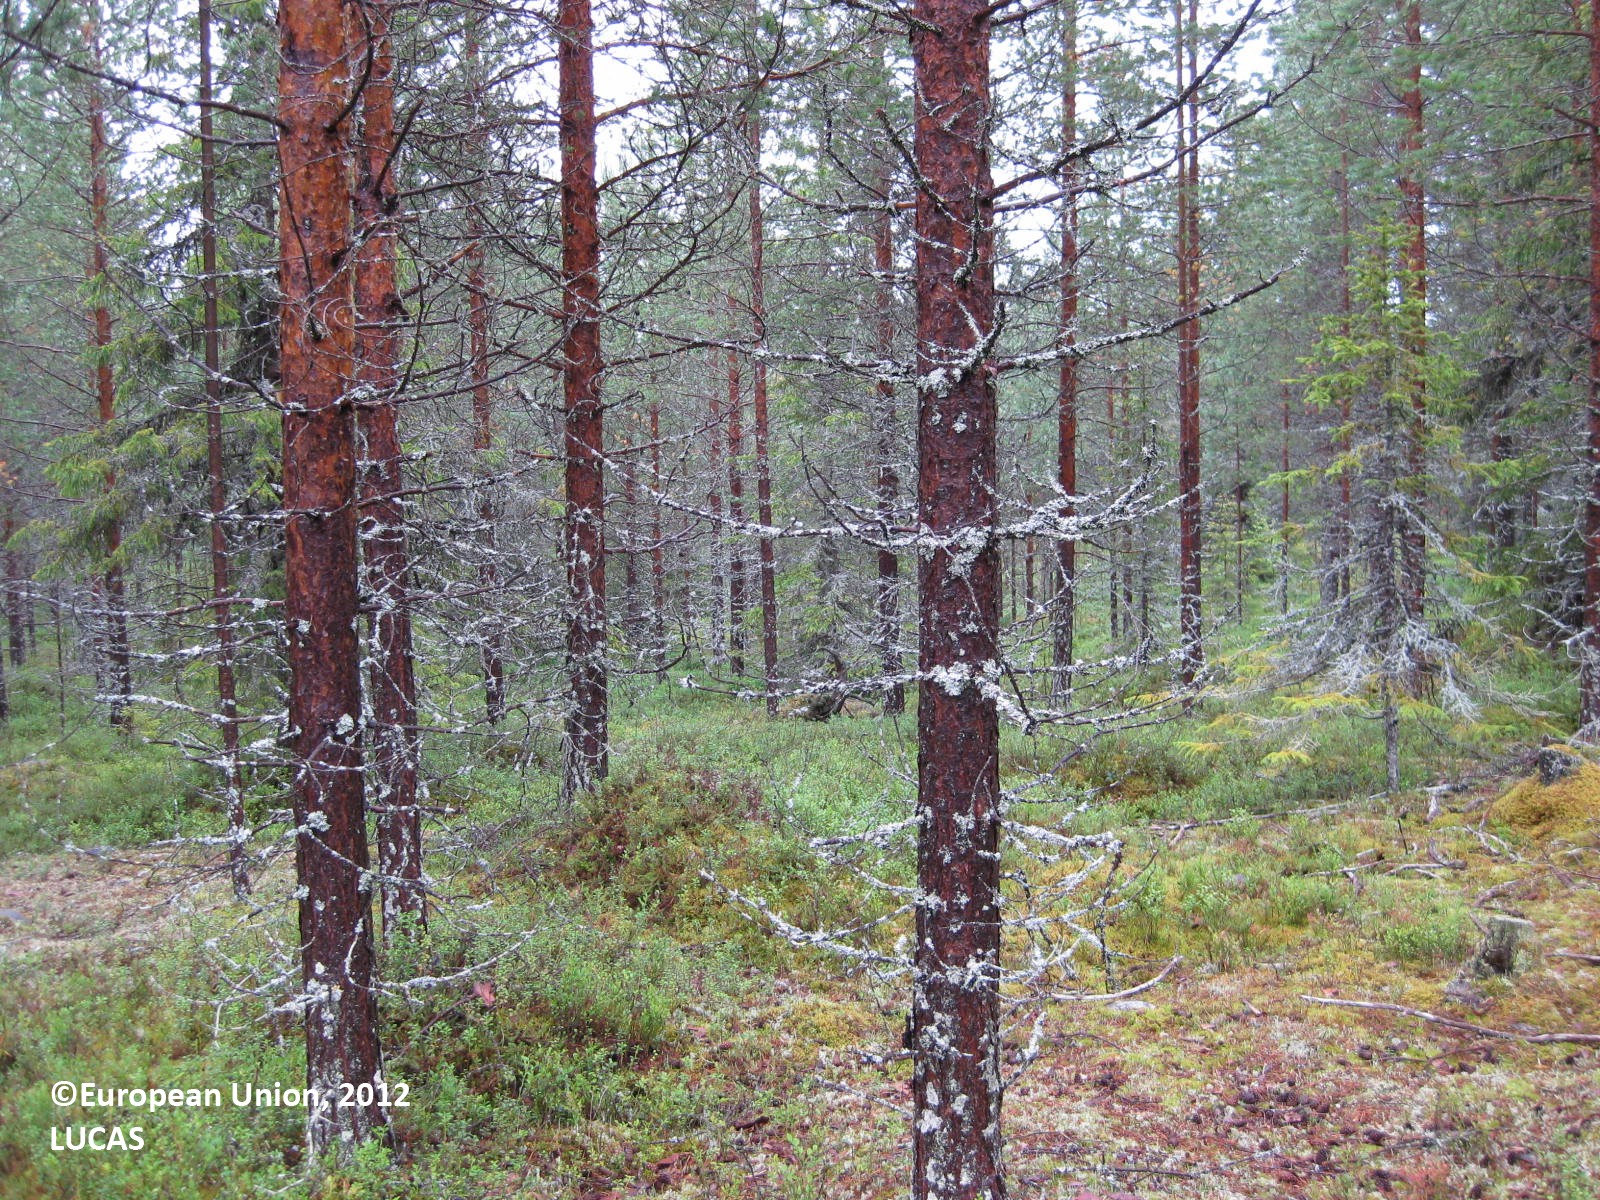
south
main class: Woodland
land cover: Pine dominated coniferous woodland
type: boreal forest
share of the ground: 50 - 75 %
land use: Forestry
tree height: > 5 m
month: August
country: FI
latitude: 65.9539
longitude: 28.2923
